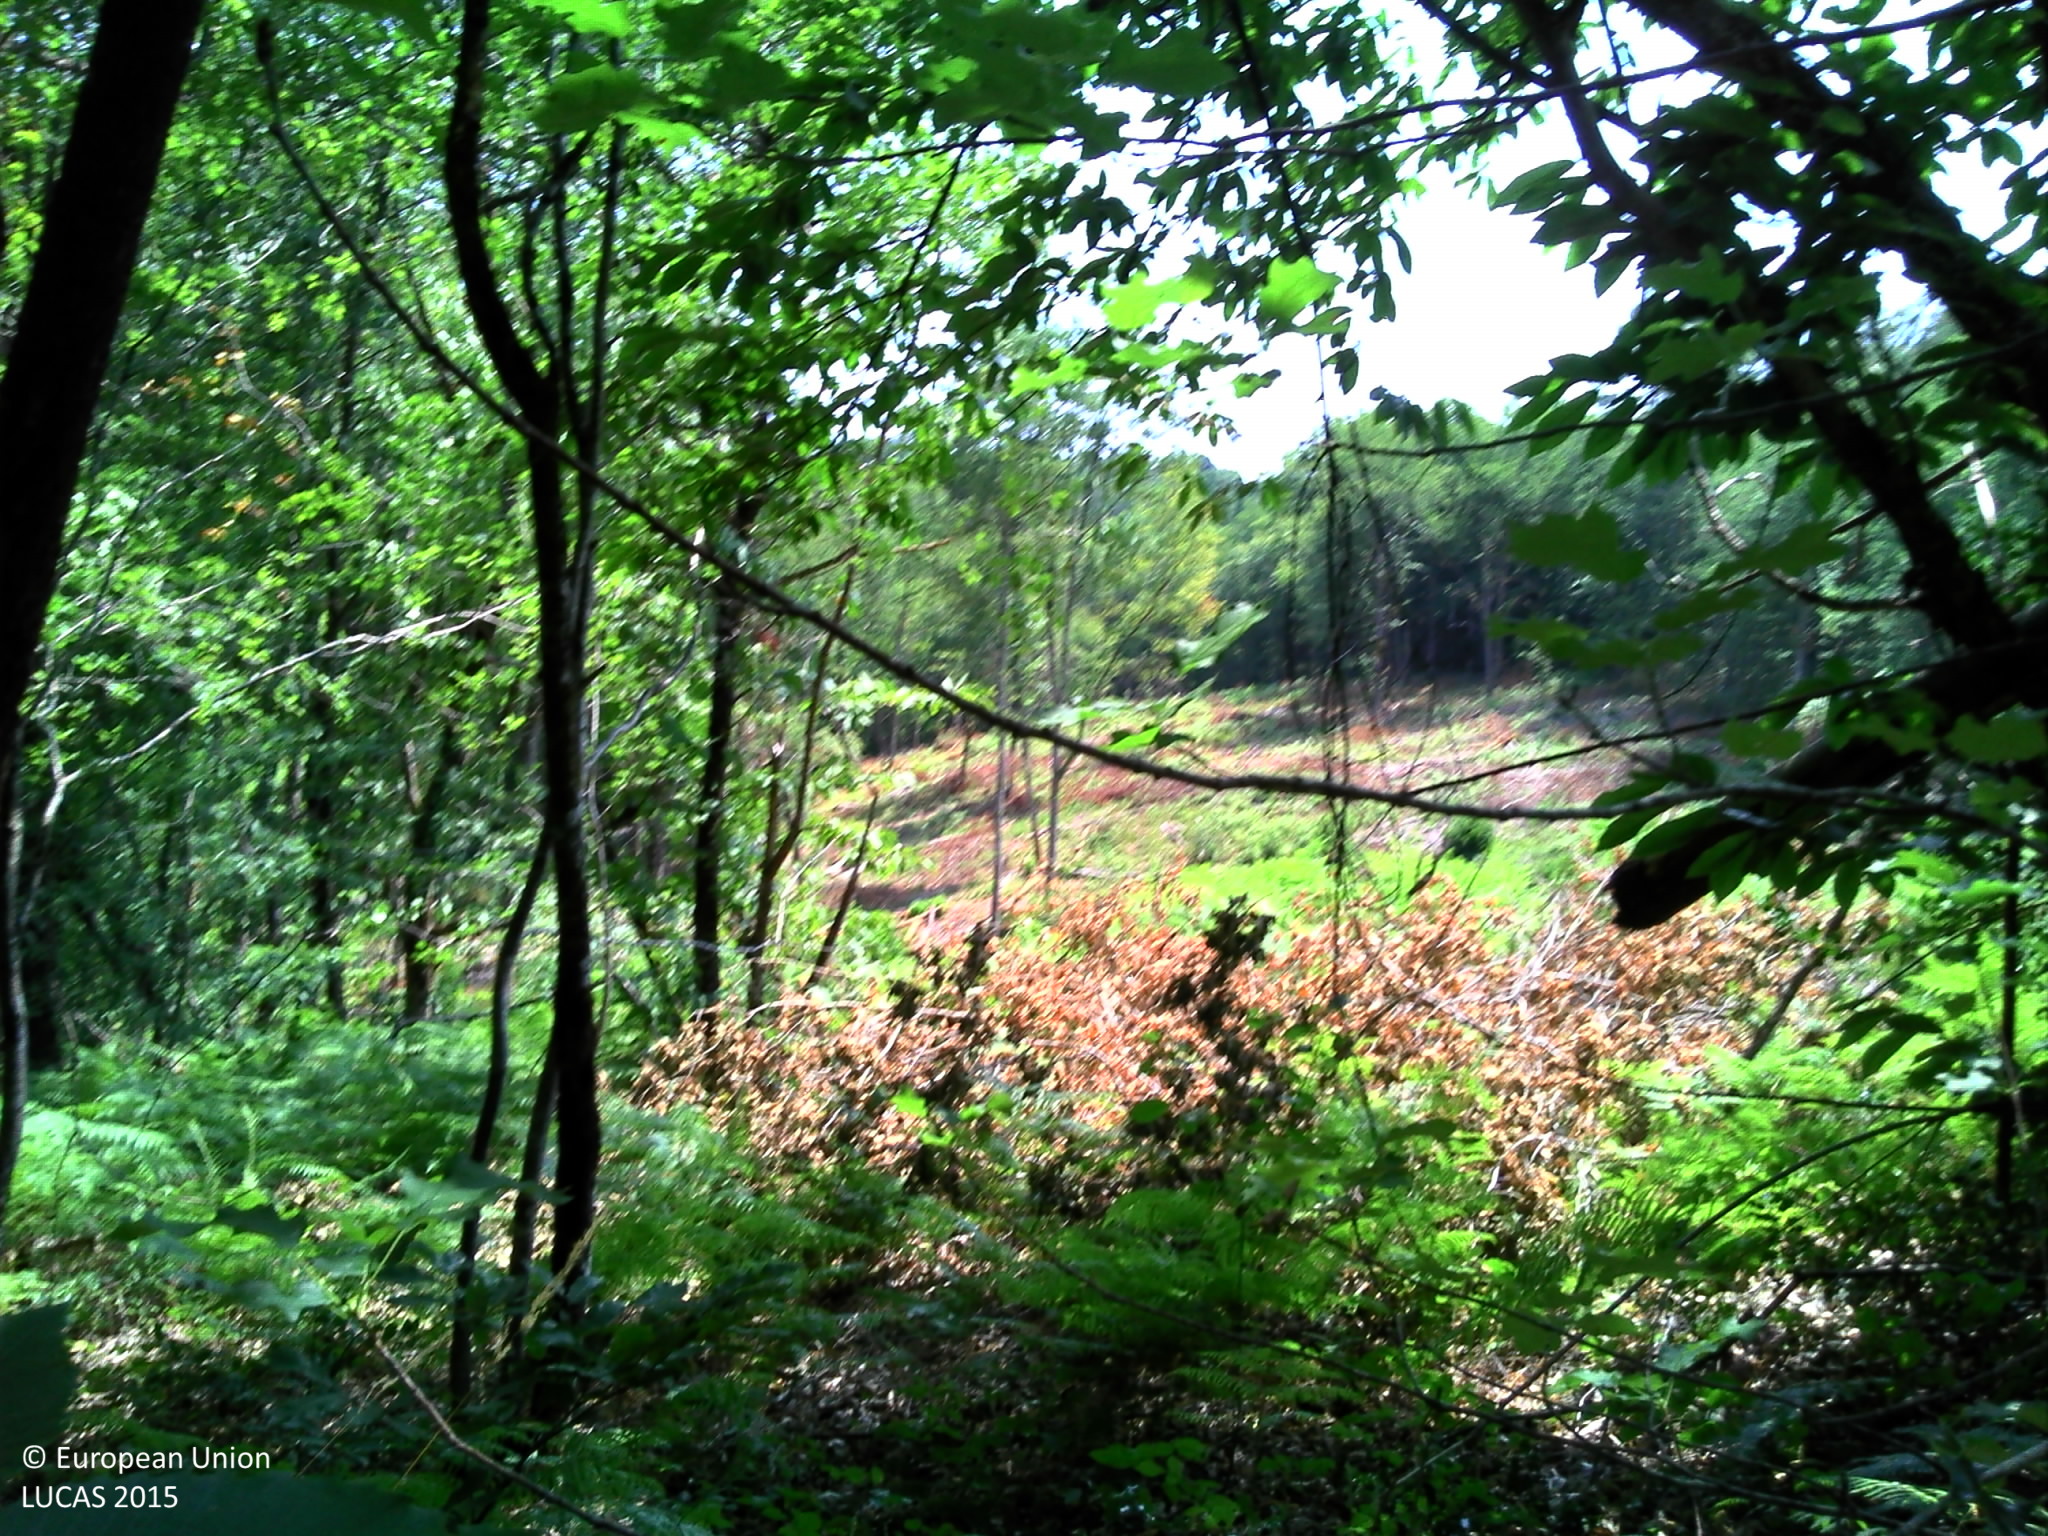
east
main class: Woodland
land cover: Broadleaved woodland
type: mesophytic deciduous forest
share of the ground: > 75 %
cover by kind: broadleaved forest trees 90 %, herbaceous plants 10 %
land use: Forestry
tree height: > 5 m
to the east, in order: Broadleaved woodland; Tracks; Broadleaved woodland; Grass margins; Electric lines; Paved roads, cycling and walking lanes; Broadleaved woodland
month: July
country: FR
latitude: 45.1514
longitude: 0.7435
